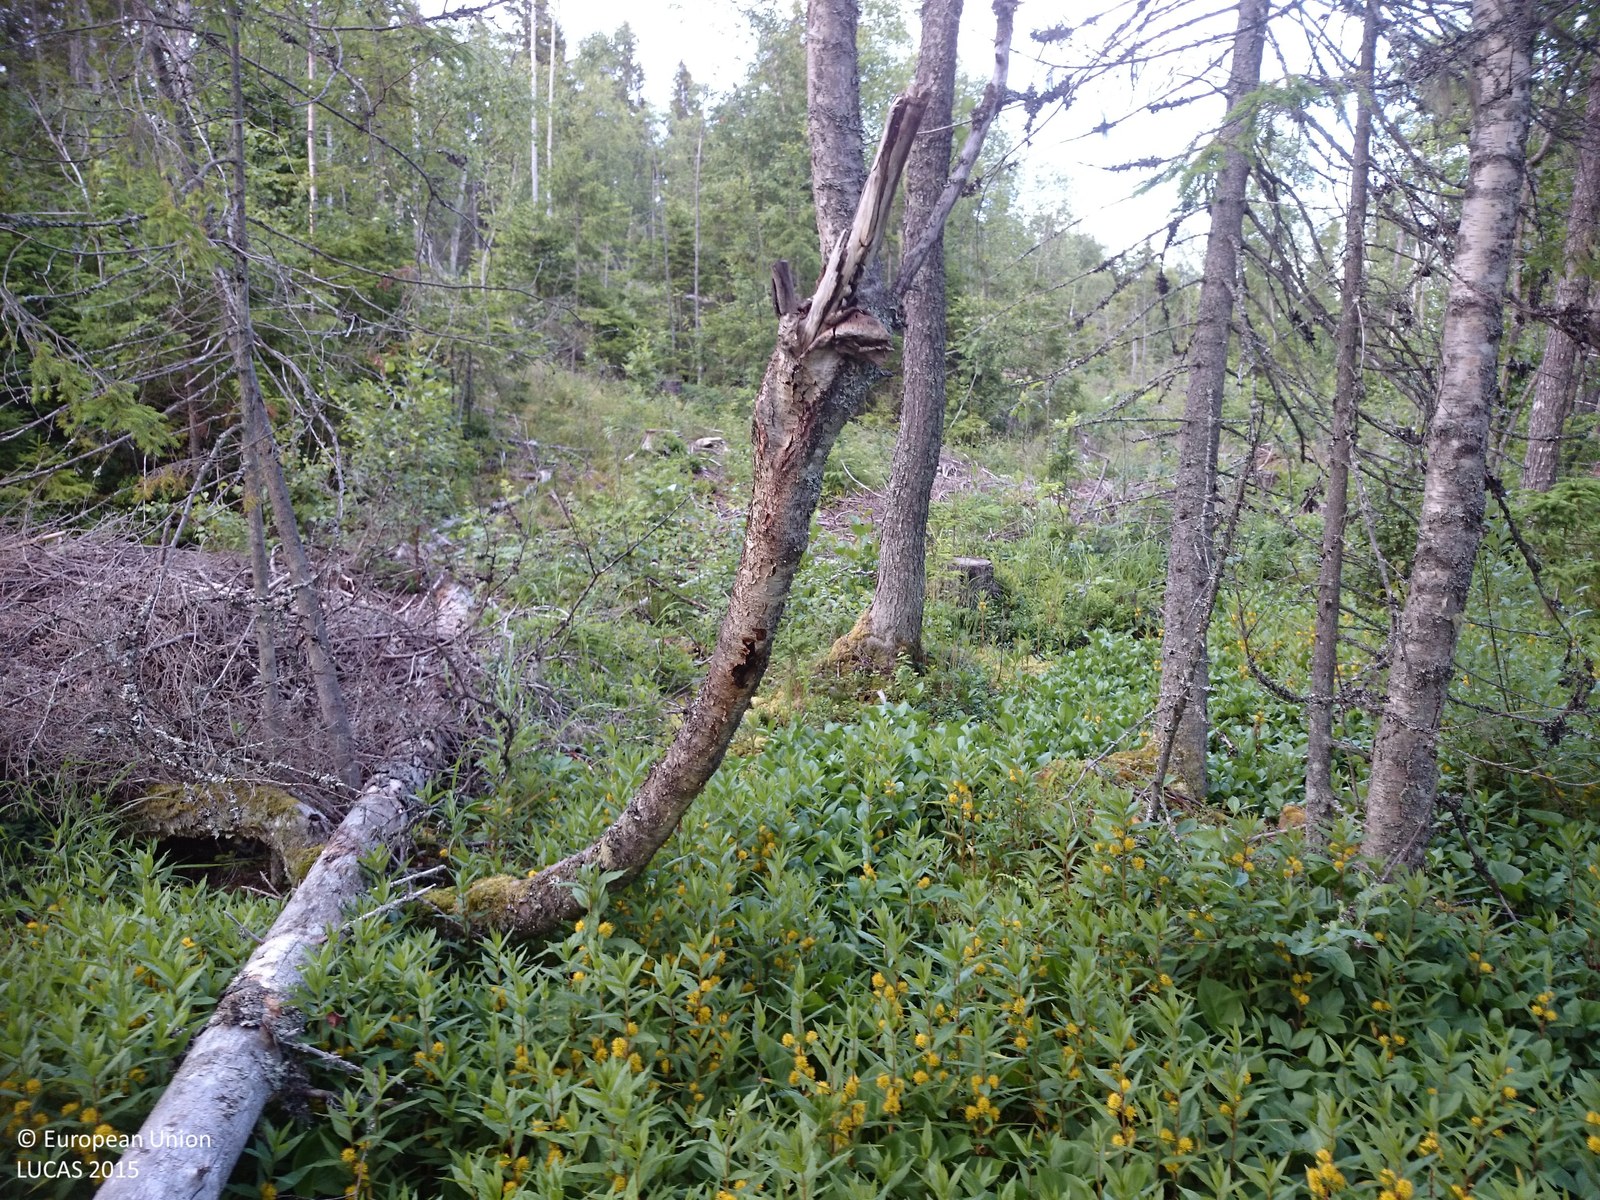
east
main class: Woodland
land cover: Broadleaved woodland
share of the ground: 50 - 75 %
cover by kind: broadleaved forest trees 45 %, herbaceous plants 40 %, coniferous forest trees 5 %
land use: Forestry
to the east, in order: Broadleaved woodland; Tracks; Spruce dominated mixed woodland; Other mixed woodland; Pine dominated coniferous woodland; Spruce dominated coniferous woodland; Rocks and stones; Other mixed woodland
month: July
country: SE
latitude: 62.4387
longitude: 17.5942
